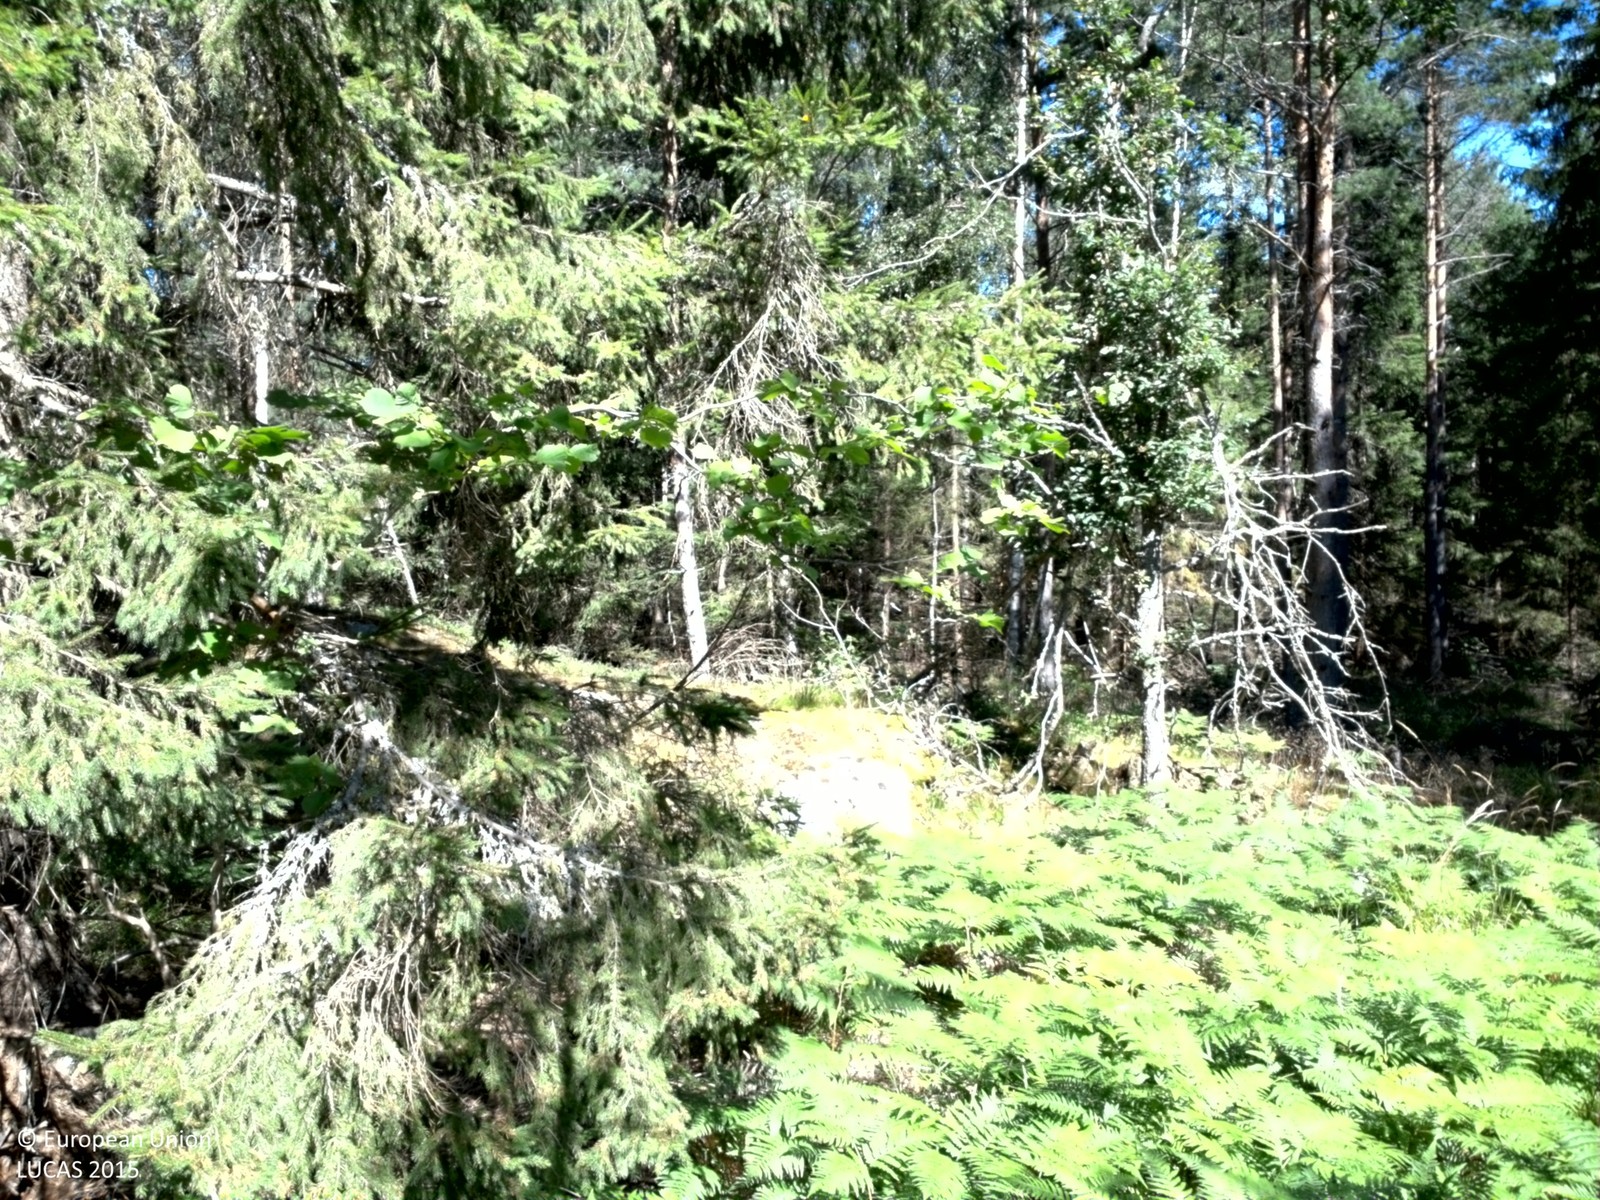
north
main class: Woodland
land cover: Spruce dominated mixed woodland
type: boreal forest
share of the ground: 25 - 50 %
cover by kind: herbaceous plants 40 %, coniferous forest trees 30 %, broadleaved forest trees 20 %, consolidated bare surface 10 %
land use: Forestry
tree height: > 5 m
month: August
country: SE
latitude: 59.5537
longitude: 18.3321
